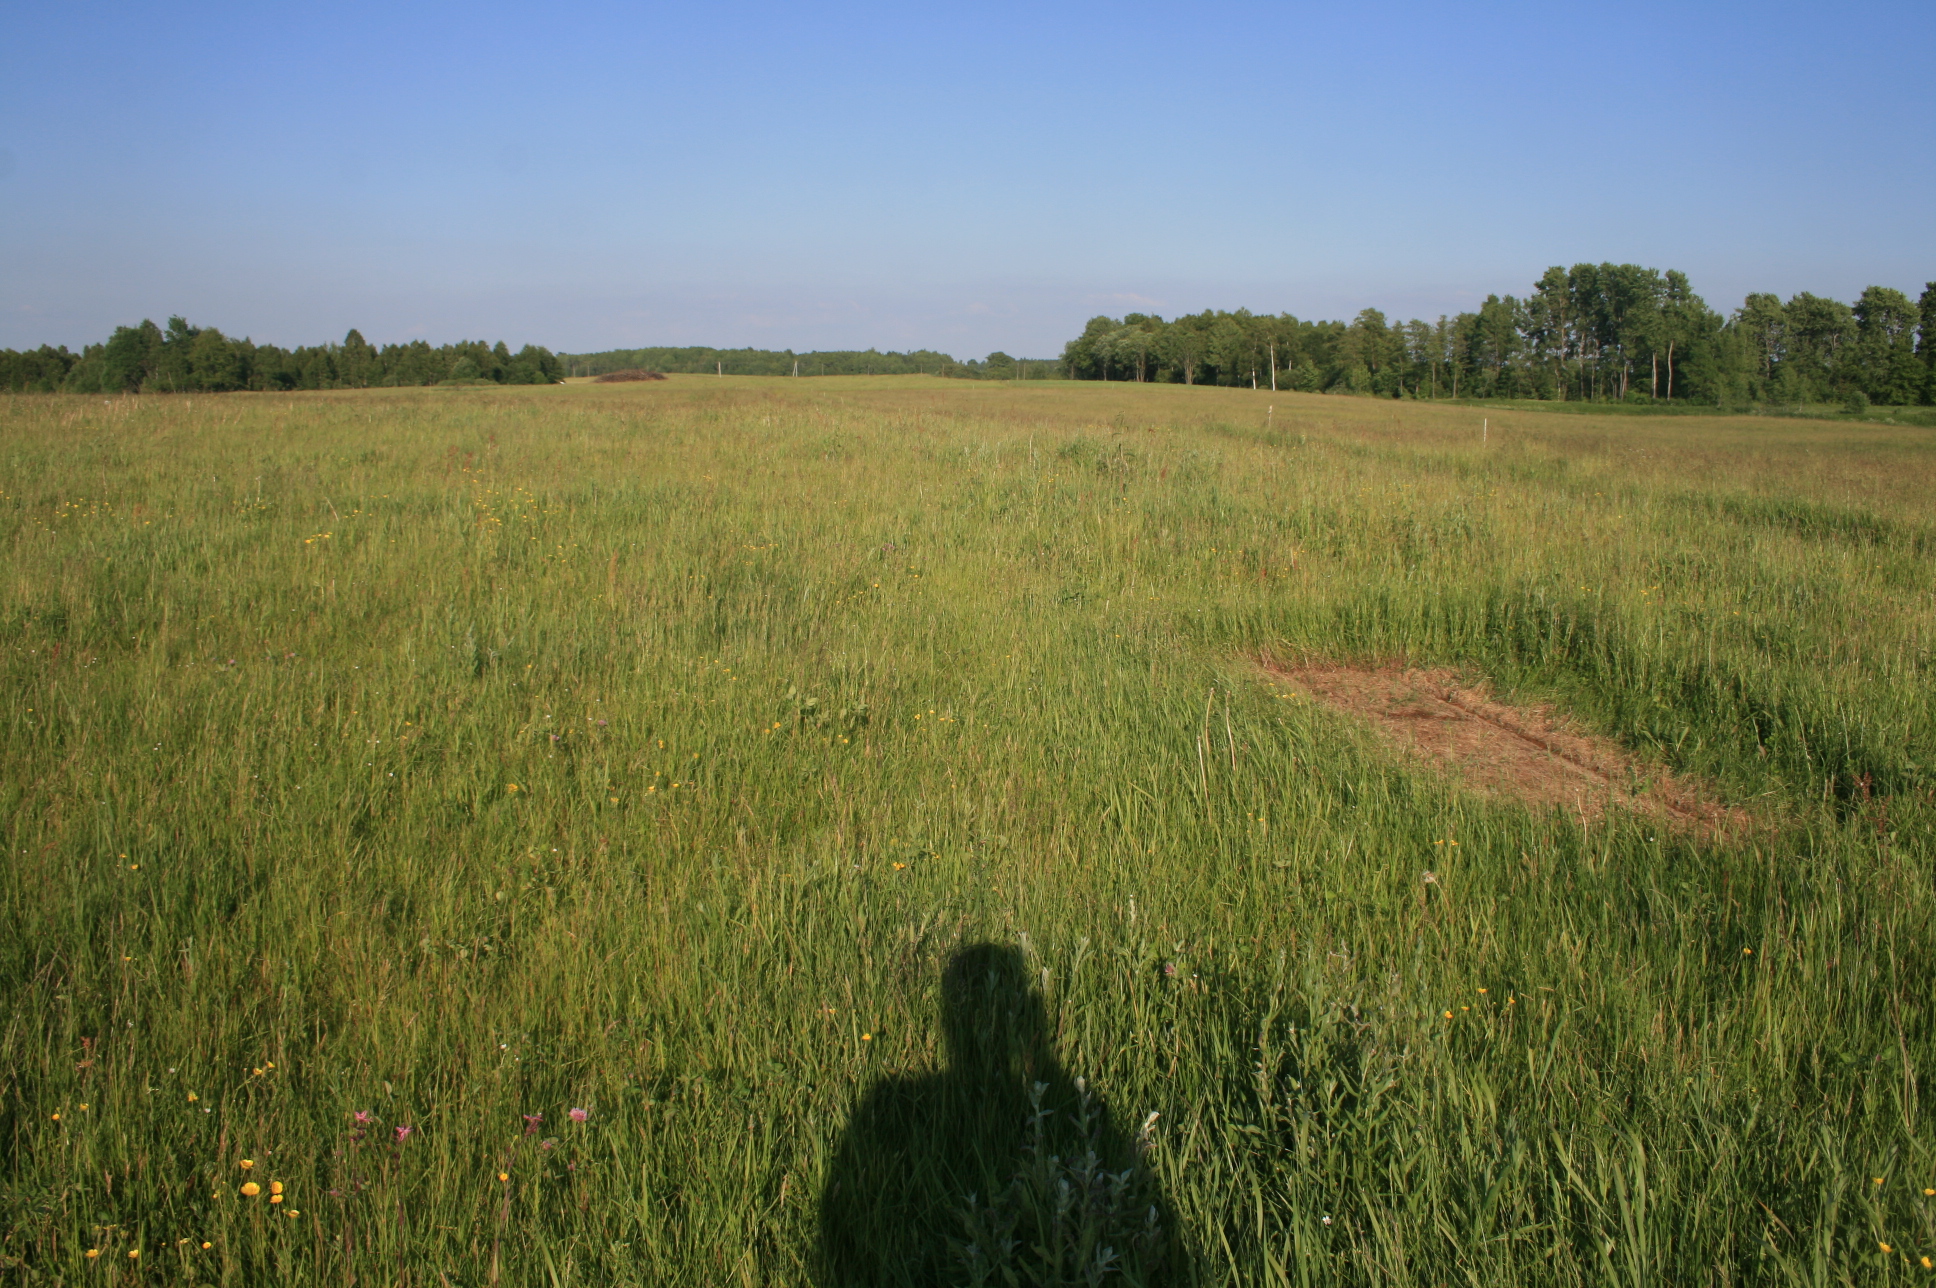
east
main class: Grassland
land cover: Grassland without tree/shrub cover
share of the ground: > 75 %
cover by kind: herbaceous plants 100 %
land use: Agriculture (excluding fallow land and kitchen gardens)
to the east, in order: Grassland without tree/shrub cover; Other leguminous and mixtures for fodder
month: June
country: LT
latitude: 55.6739
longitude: 22.2201
